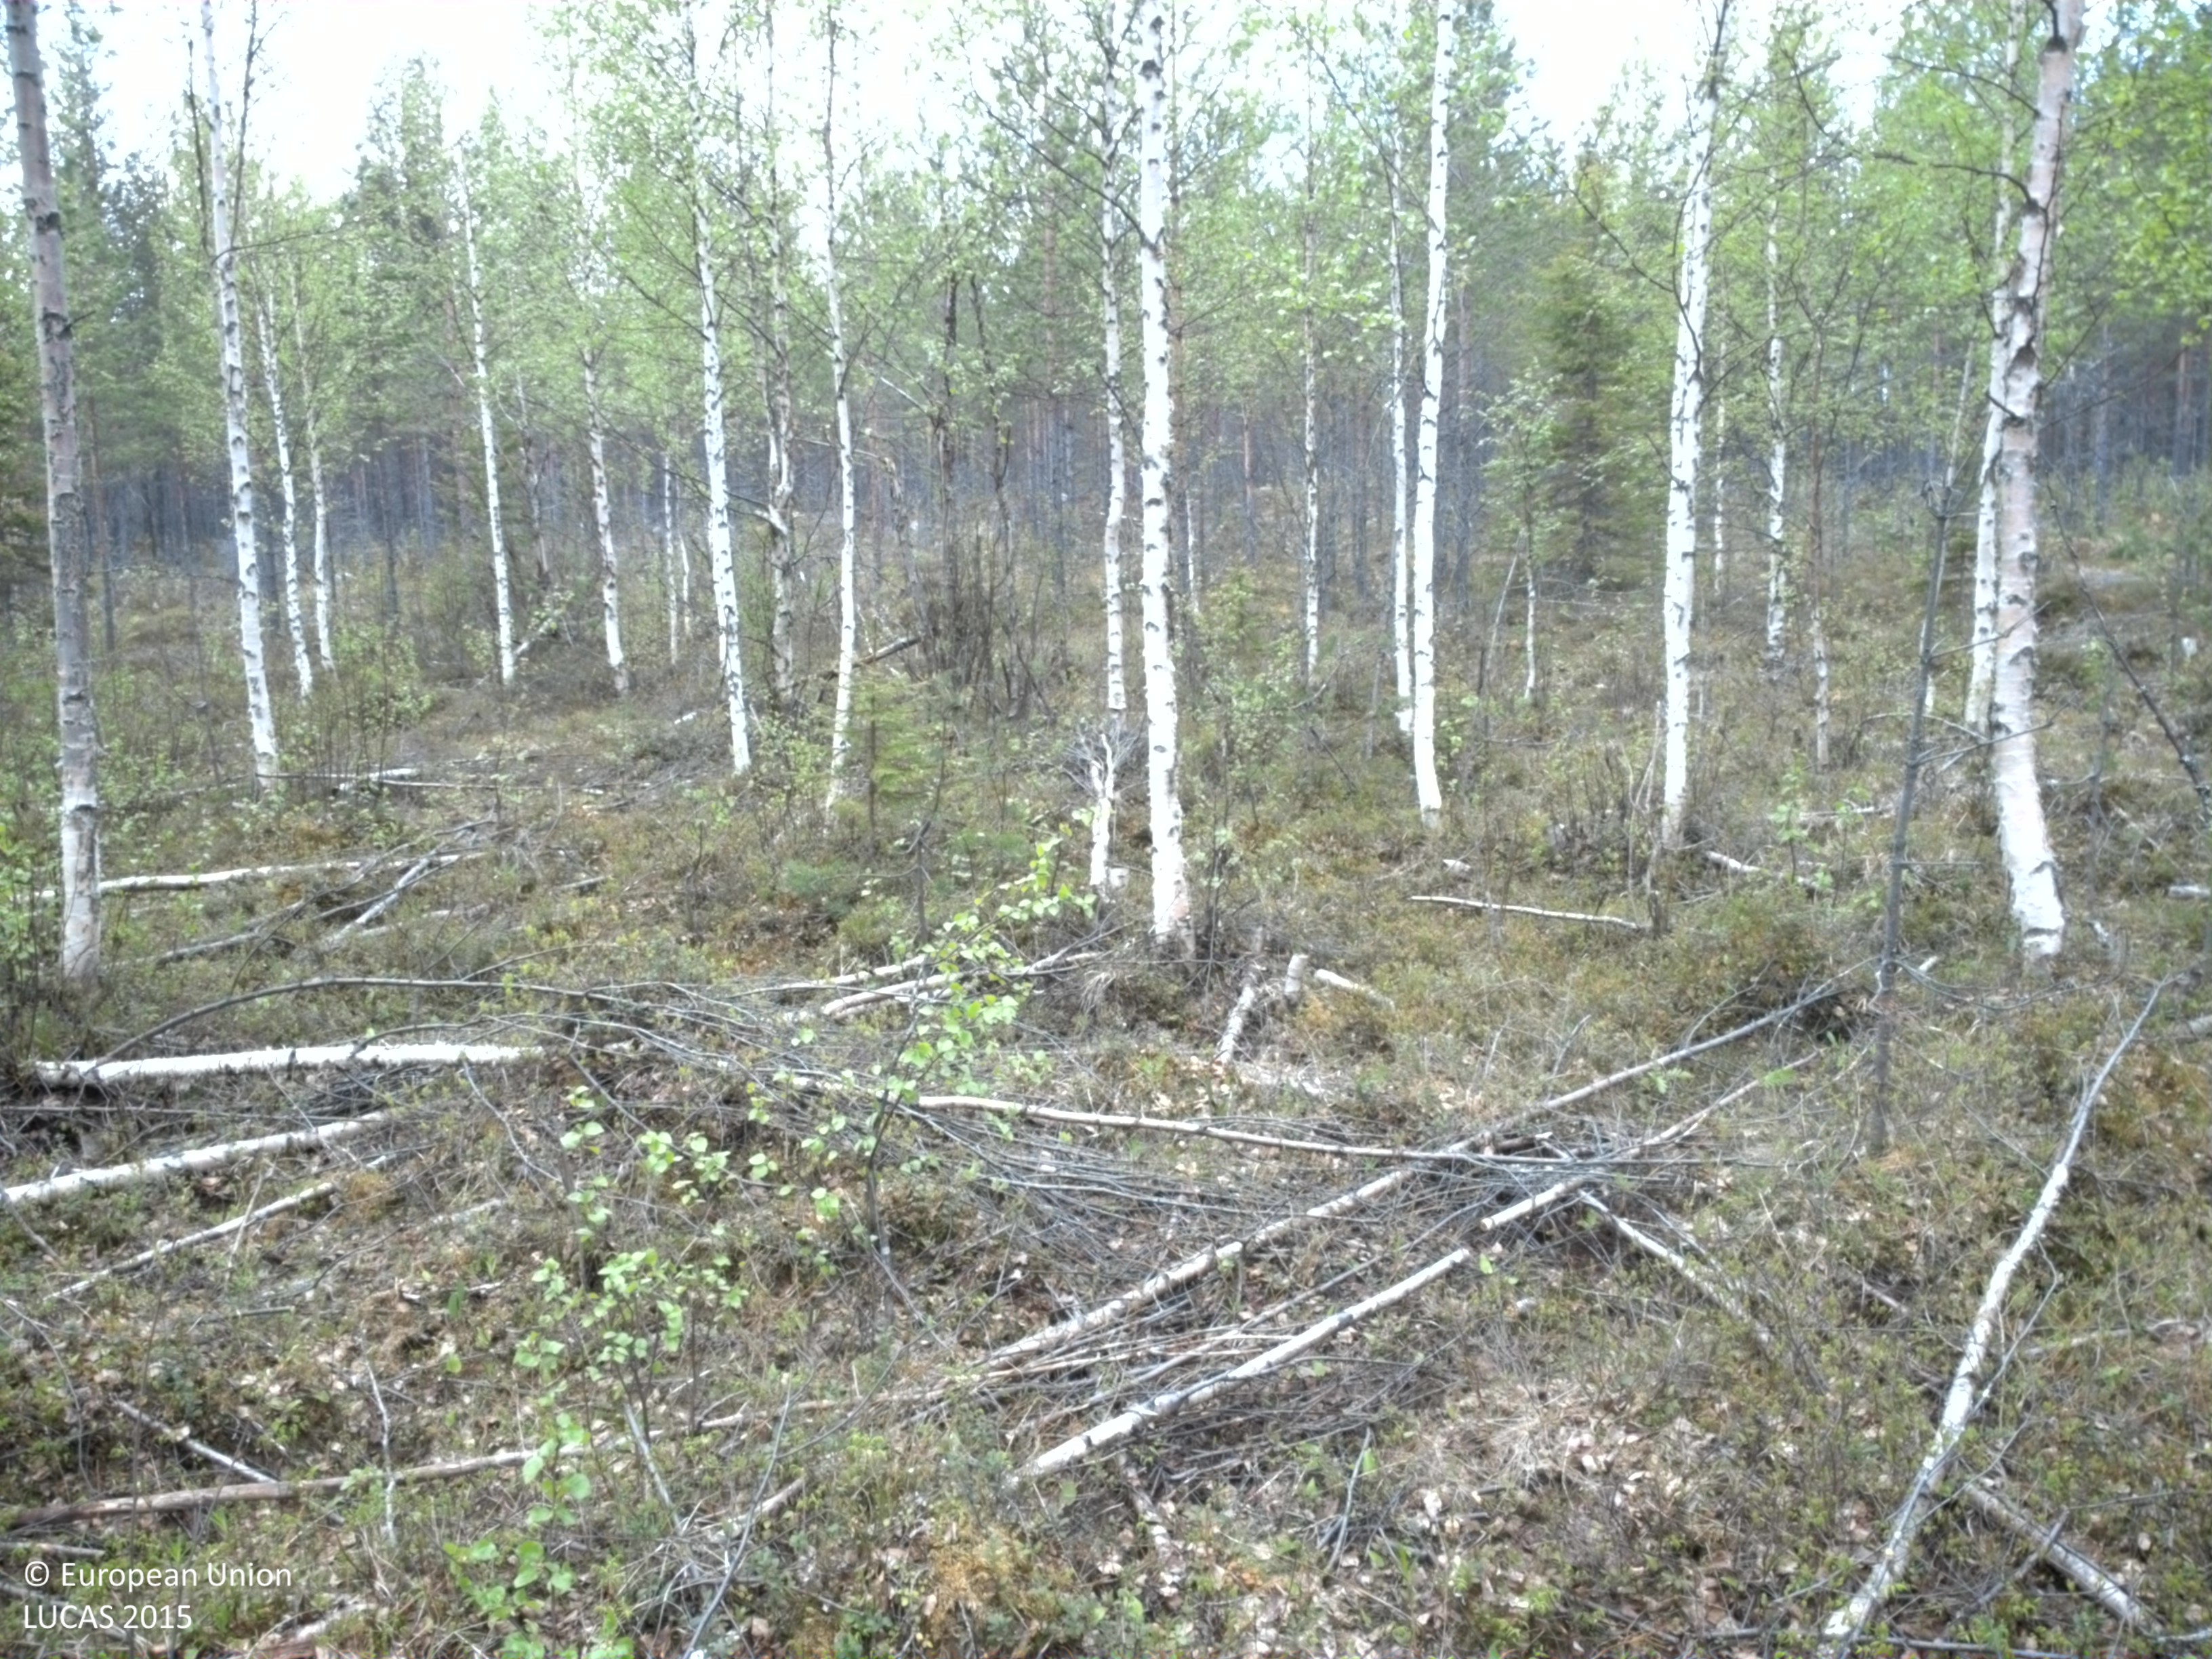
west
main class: Woodland
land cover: Broadleaved woodland
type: boreal forest
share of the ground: 50 - 75 %
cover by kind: broadleaved forest trees 70 %, shrubs 25 %, coniferous forest trees 5 %
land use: Forestry
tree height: > 5 m
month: June
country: SE
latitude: 66.5393
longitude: 22.3271
